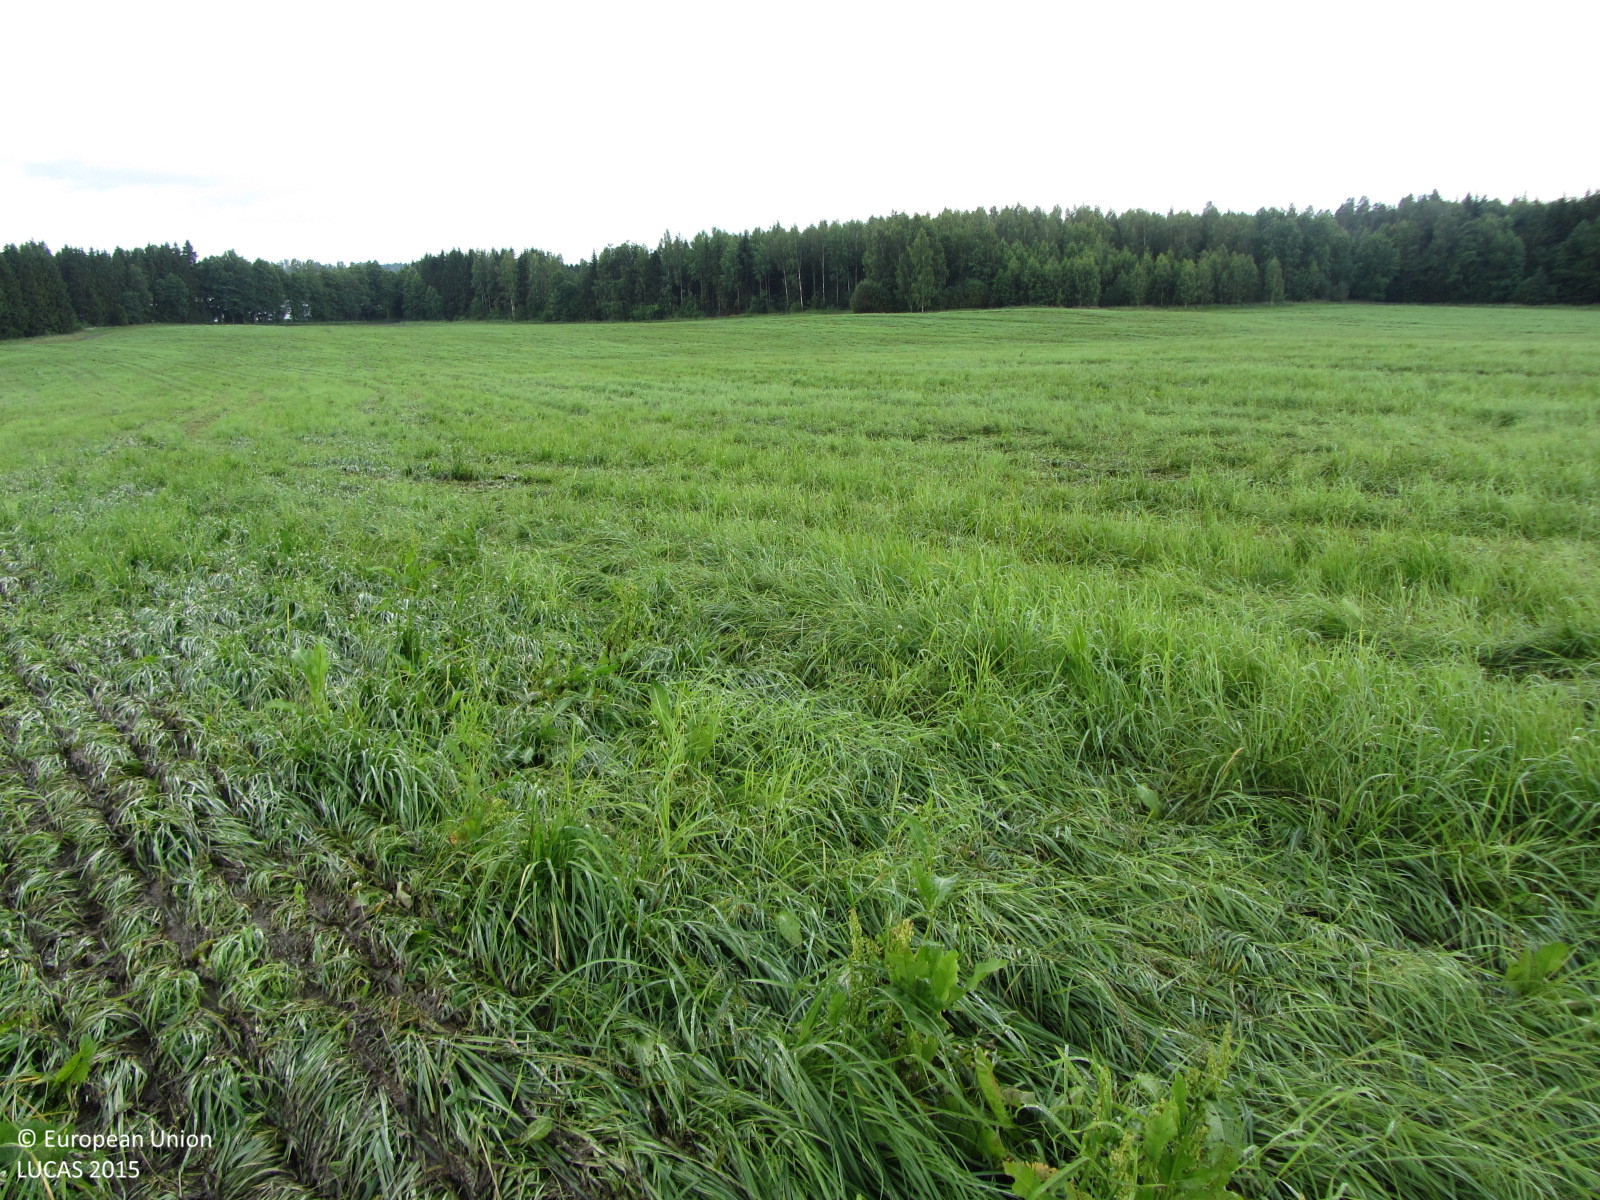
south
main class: Grassland
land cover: Grassland without tree/shrub cover
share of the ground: > 75 %
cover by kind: herbaceous plants 100 %
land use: Agriculture (excluding fallow land and kitchen gardens)
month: July
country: FI
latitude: 60.0495
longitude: 23.2111
